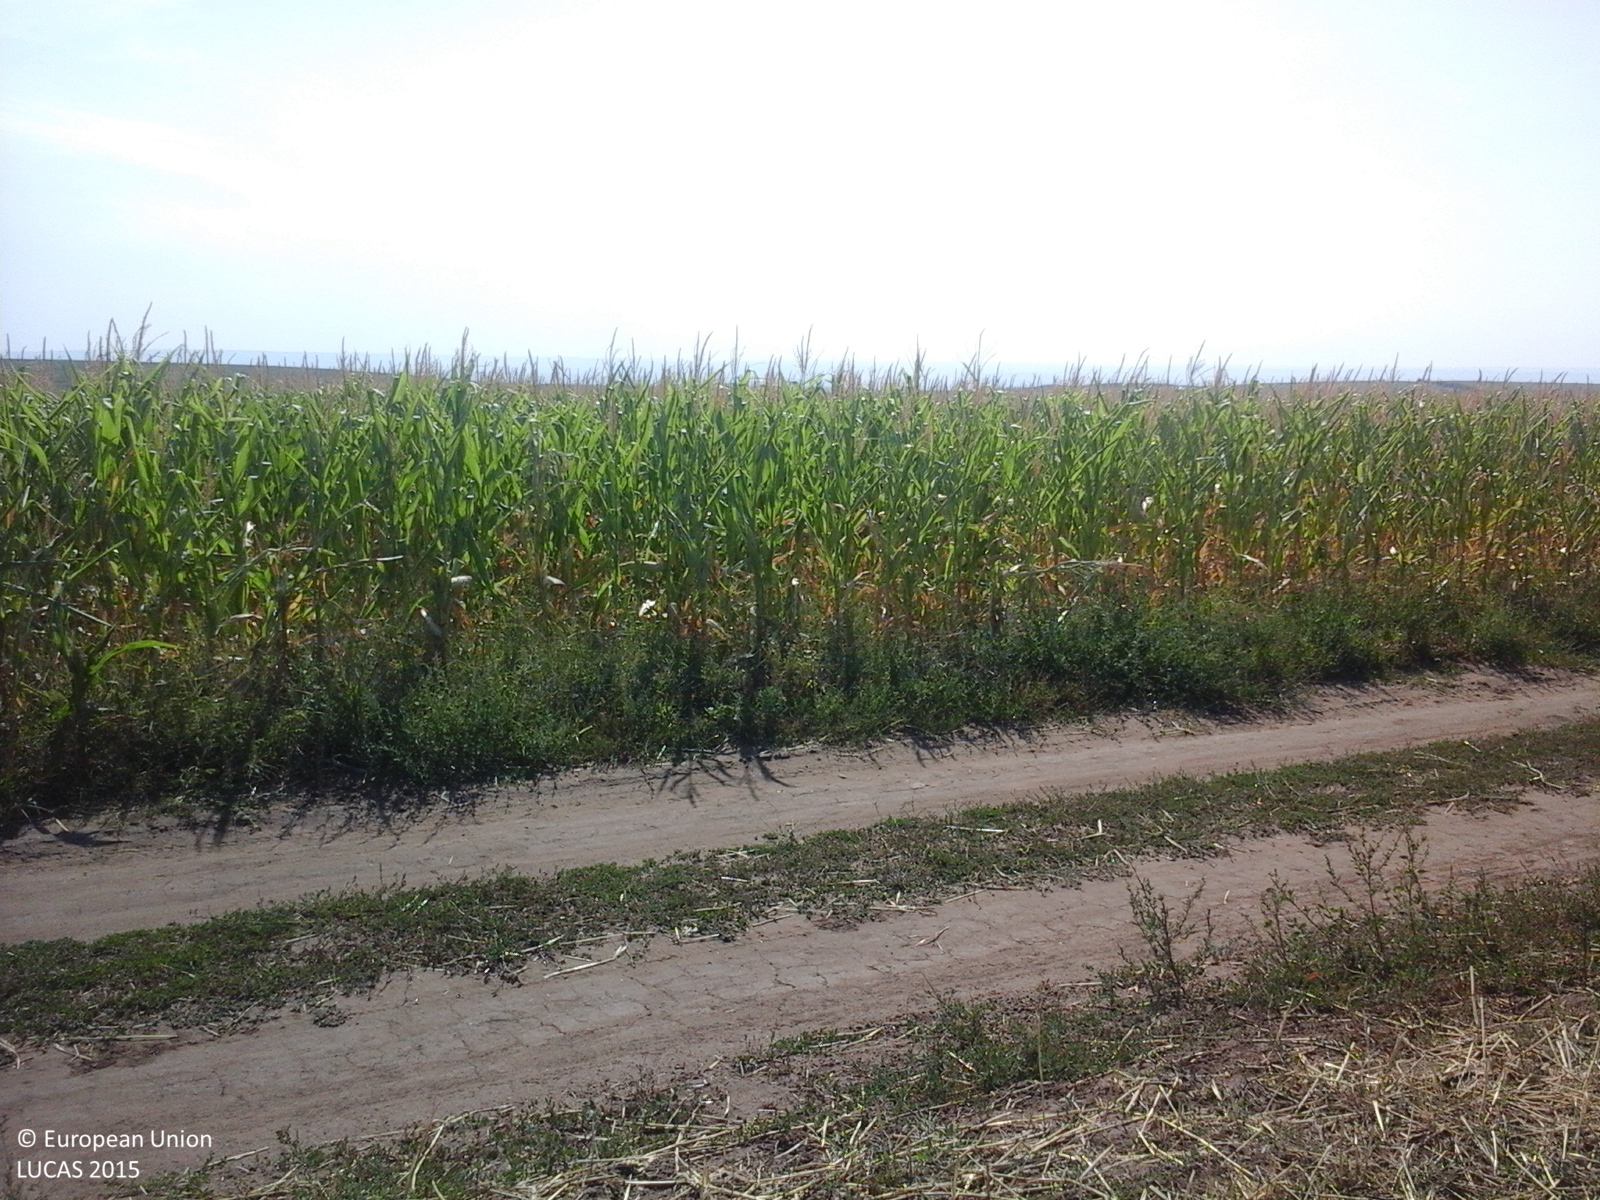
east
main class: Cropland
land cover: Common wheat
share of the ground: 25 - 50 %
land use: Agriculture (excluding fallow land and kitchen gardens)
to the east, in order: Common wheat; Grass margins; Tracks; Grass margins; Maize; Shrubland with sparse tree cover; Ditches and canals; Shrubland with sparse tree cover; Common wheat; Abandoned hedges; Common wheat
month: July
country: RO
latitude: 46.3138
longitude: 28.0337
